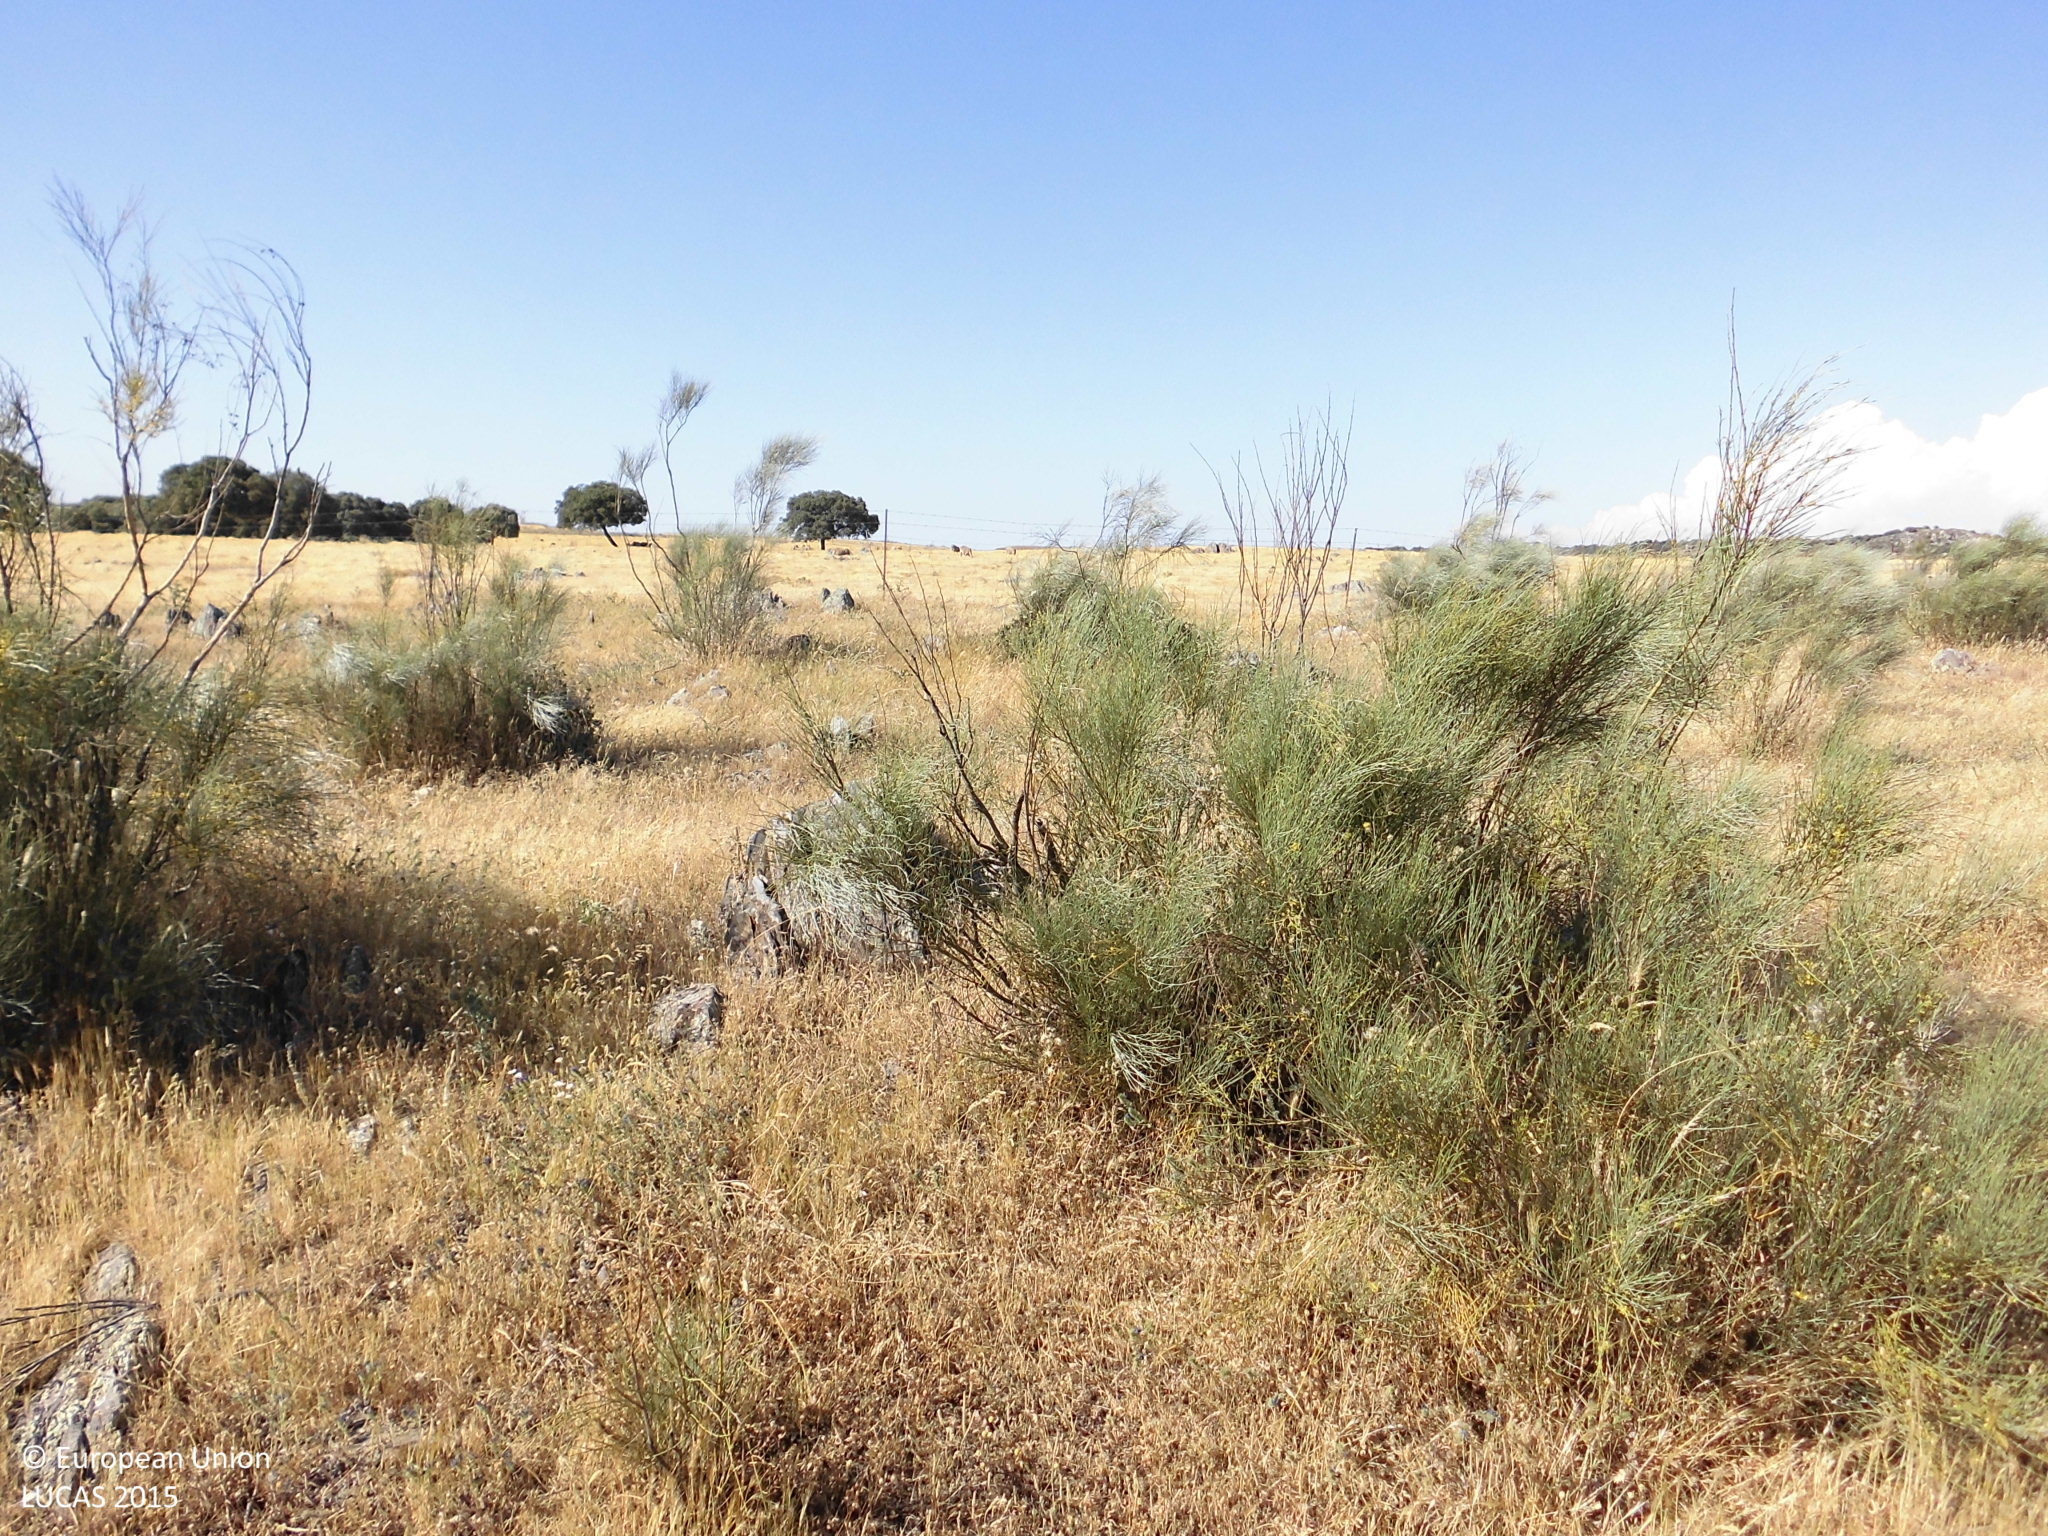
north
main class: Shrubland
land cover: Shrubland without tree cover
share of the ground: 10 - 25 %
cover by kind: herbaceous plants 85 %, shrubs 15 %
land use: Agriculture (excluding fallow land and kitchen gardens)
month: May
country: ES
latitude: 39.4103
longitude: -6.0768
